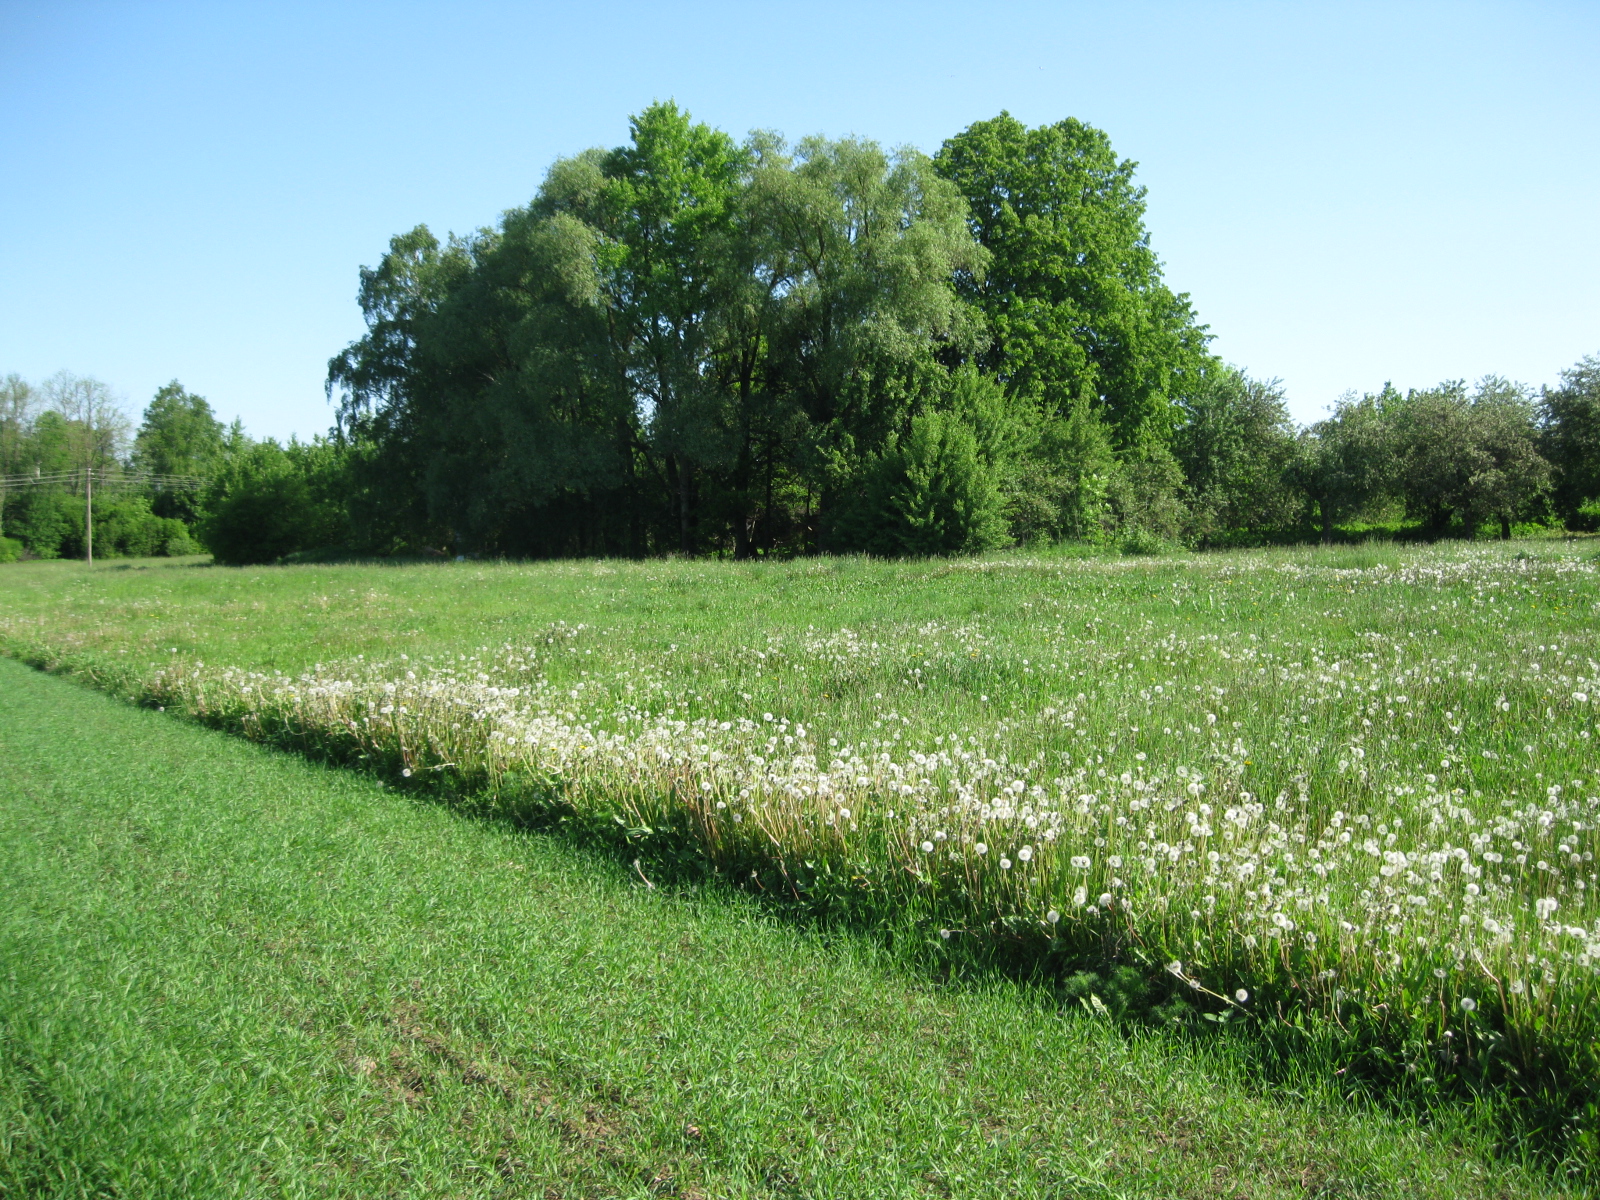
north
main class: Cropland
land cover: Common wheat
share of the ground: > 75 %
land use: Agriculture (excluding fallow land and kitchen gardens)
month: May
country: LT
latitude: 55.8656
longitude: 24.8558
